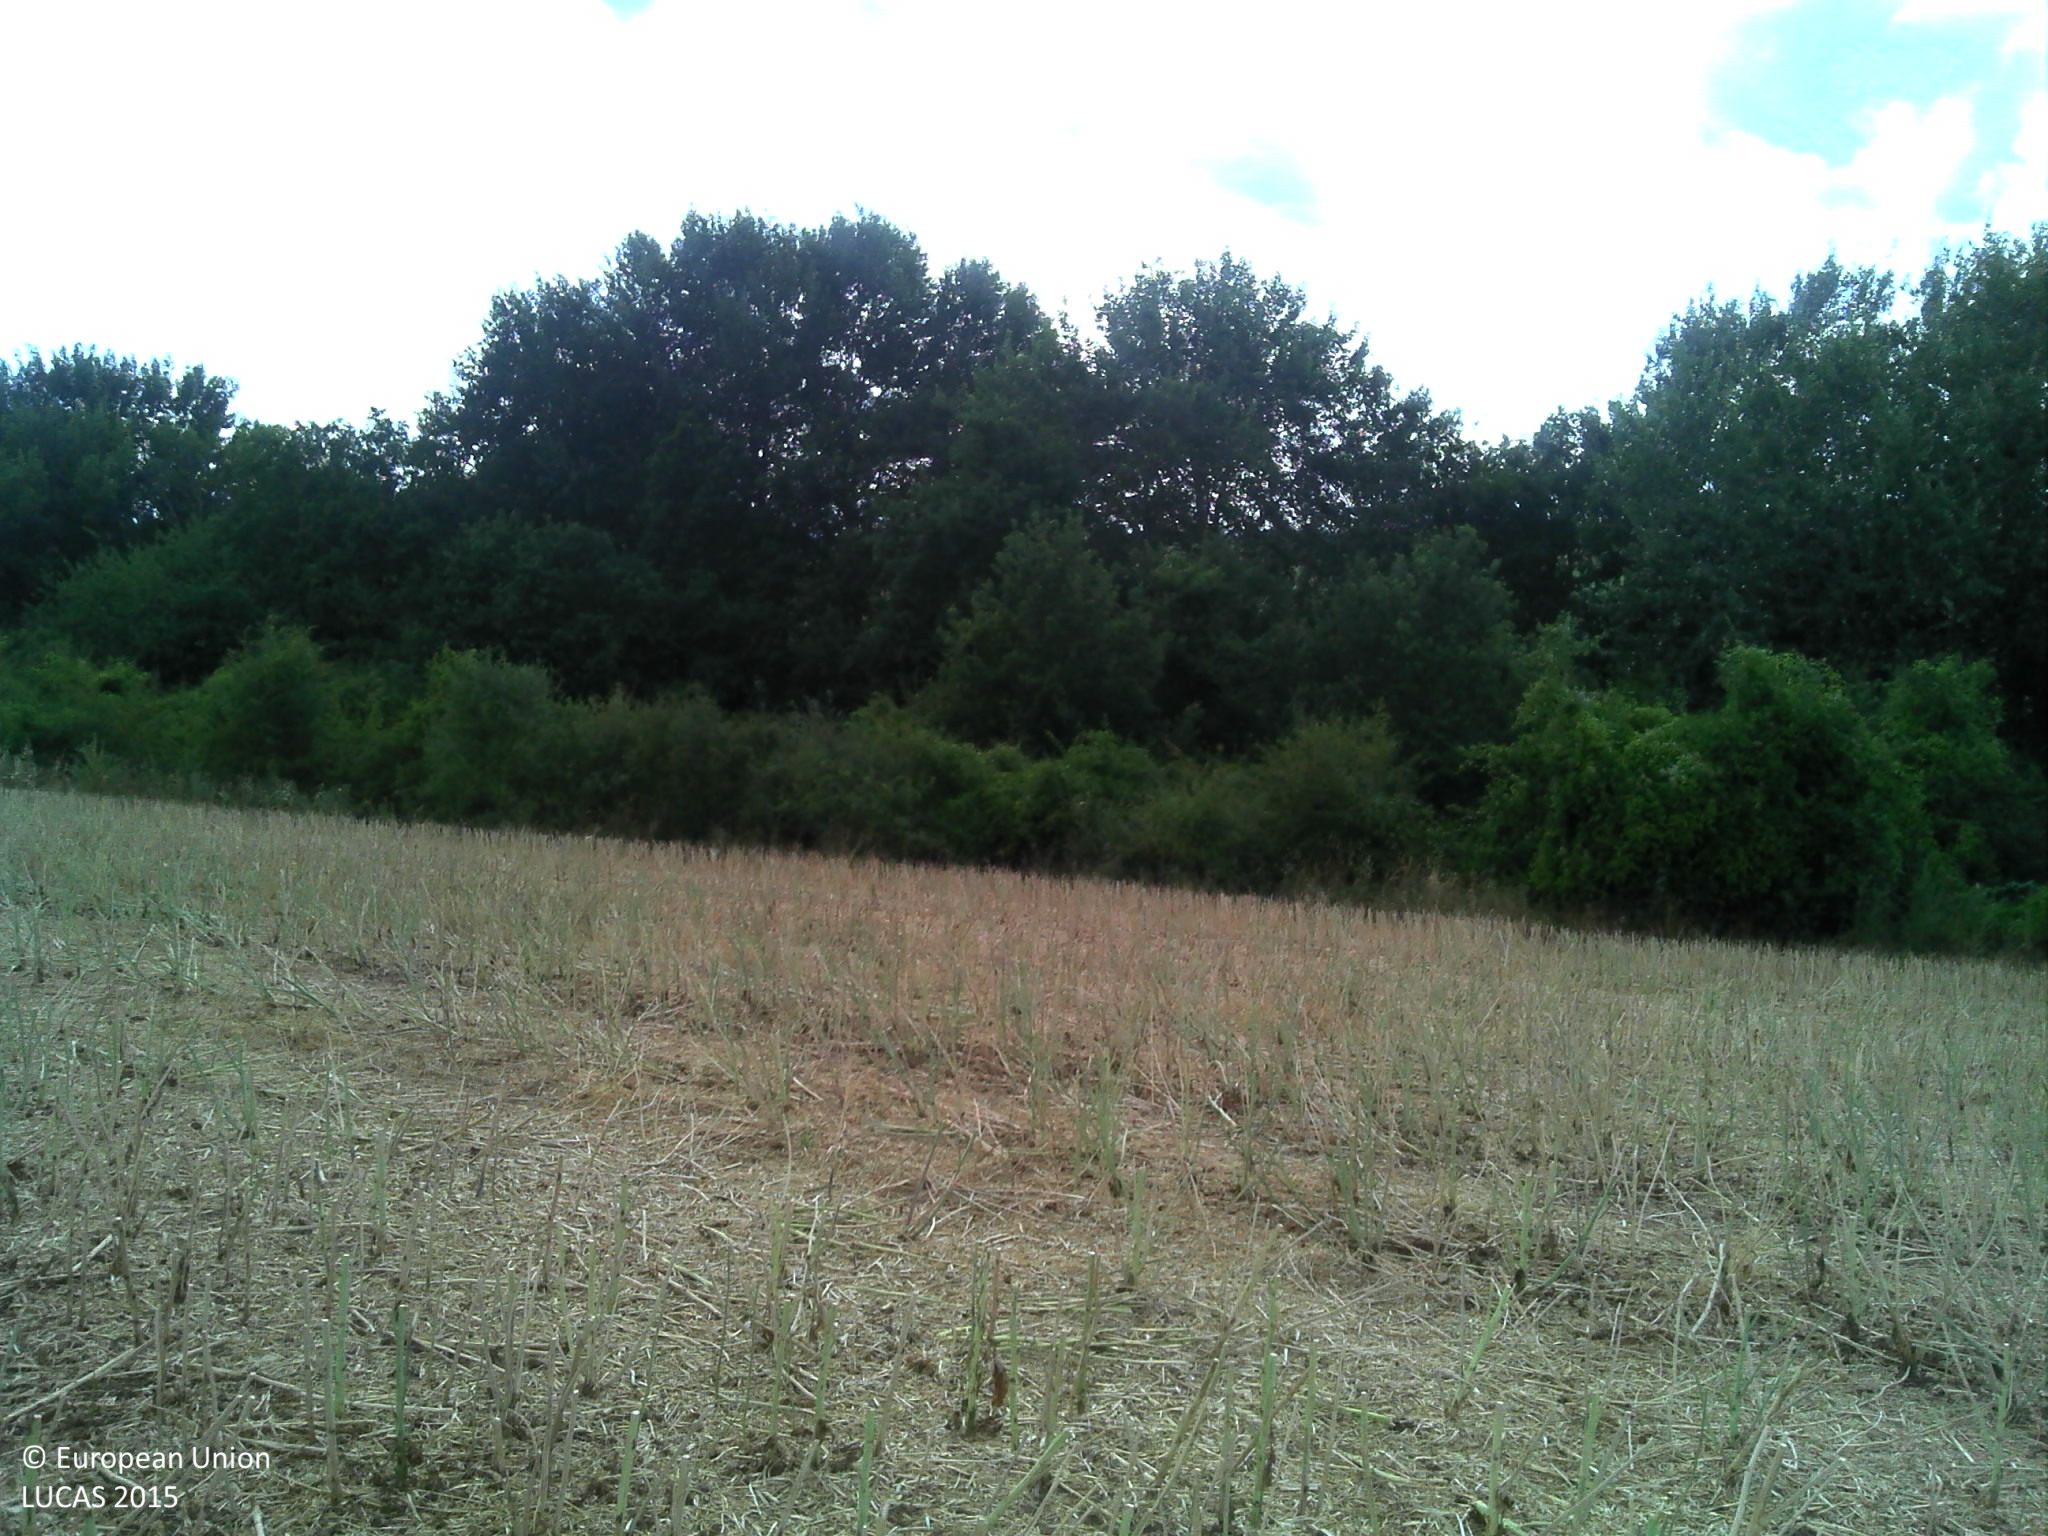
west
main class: Cropland
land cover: Rape and turnip rape
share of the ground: > 75 %
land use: Agriculture (excluding fallow land and kitchen gardens)
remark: Harvested field
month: July
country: FR
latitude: 47.9888
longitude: 1.3136
